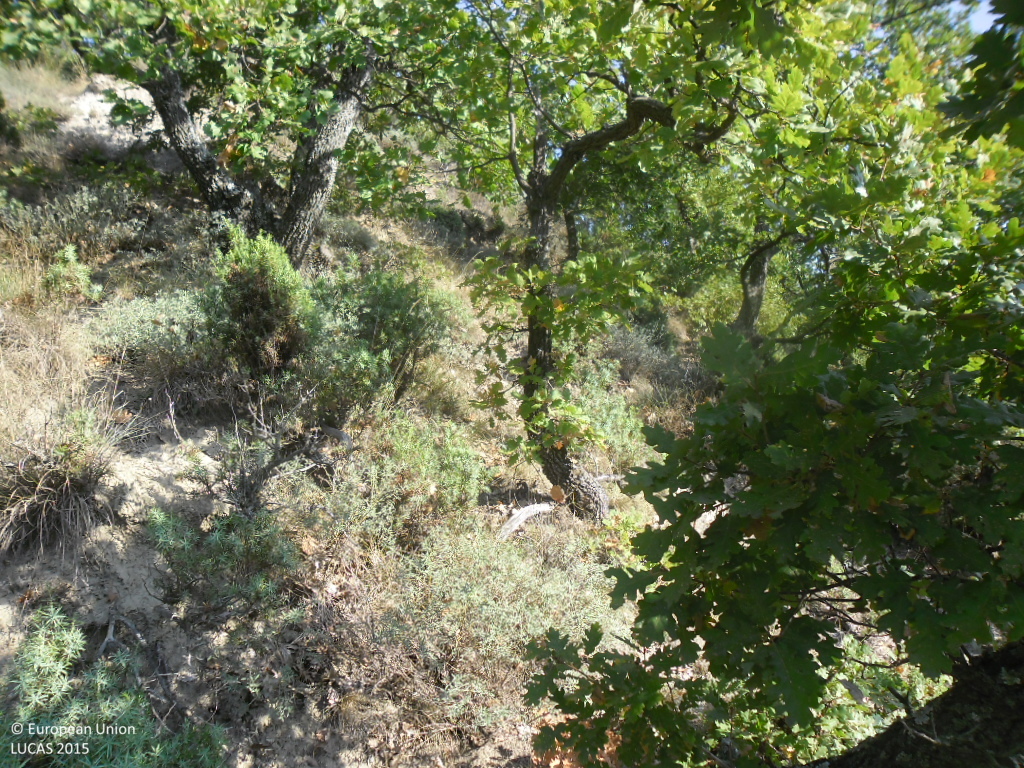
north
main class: Woodland
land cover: Broadleaved woodland
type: thermophilous deciduous forest
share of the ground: > 75 %
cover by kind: broadleaved forest trees 95 %, unconsolidated bare surface 5 %
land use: Forestry
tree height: > 5 m
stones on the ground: < 10 %
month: September
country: BG
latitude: 41.8665
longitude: 23.1432
